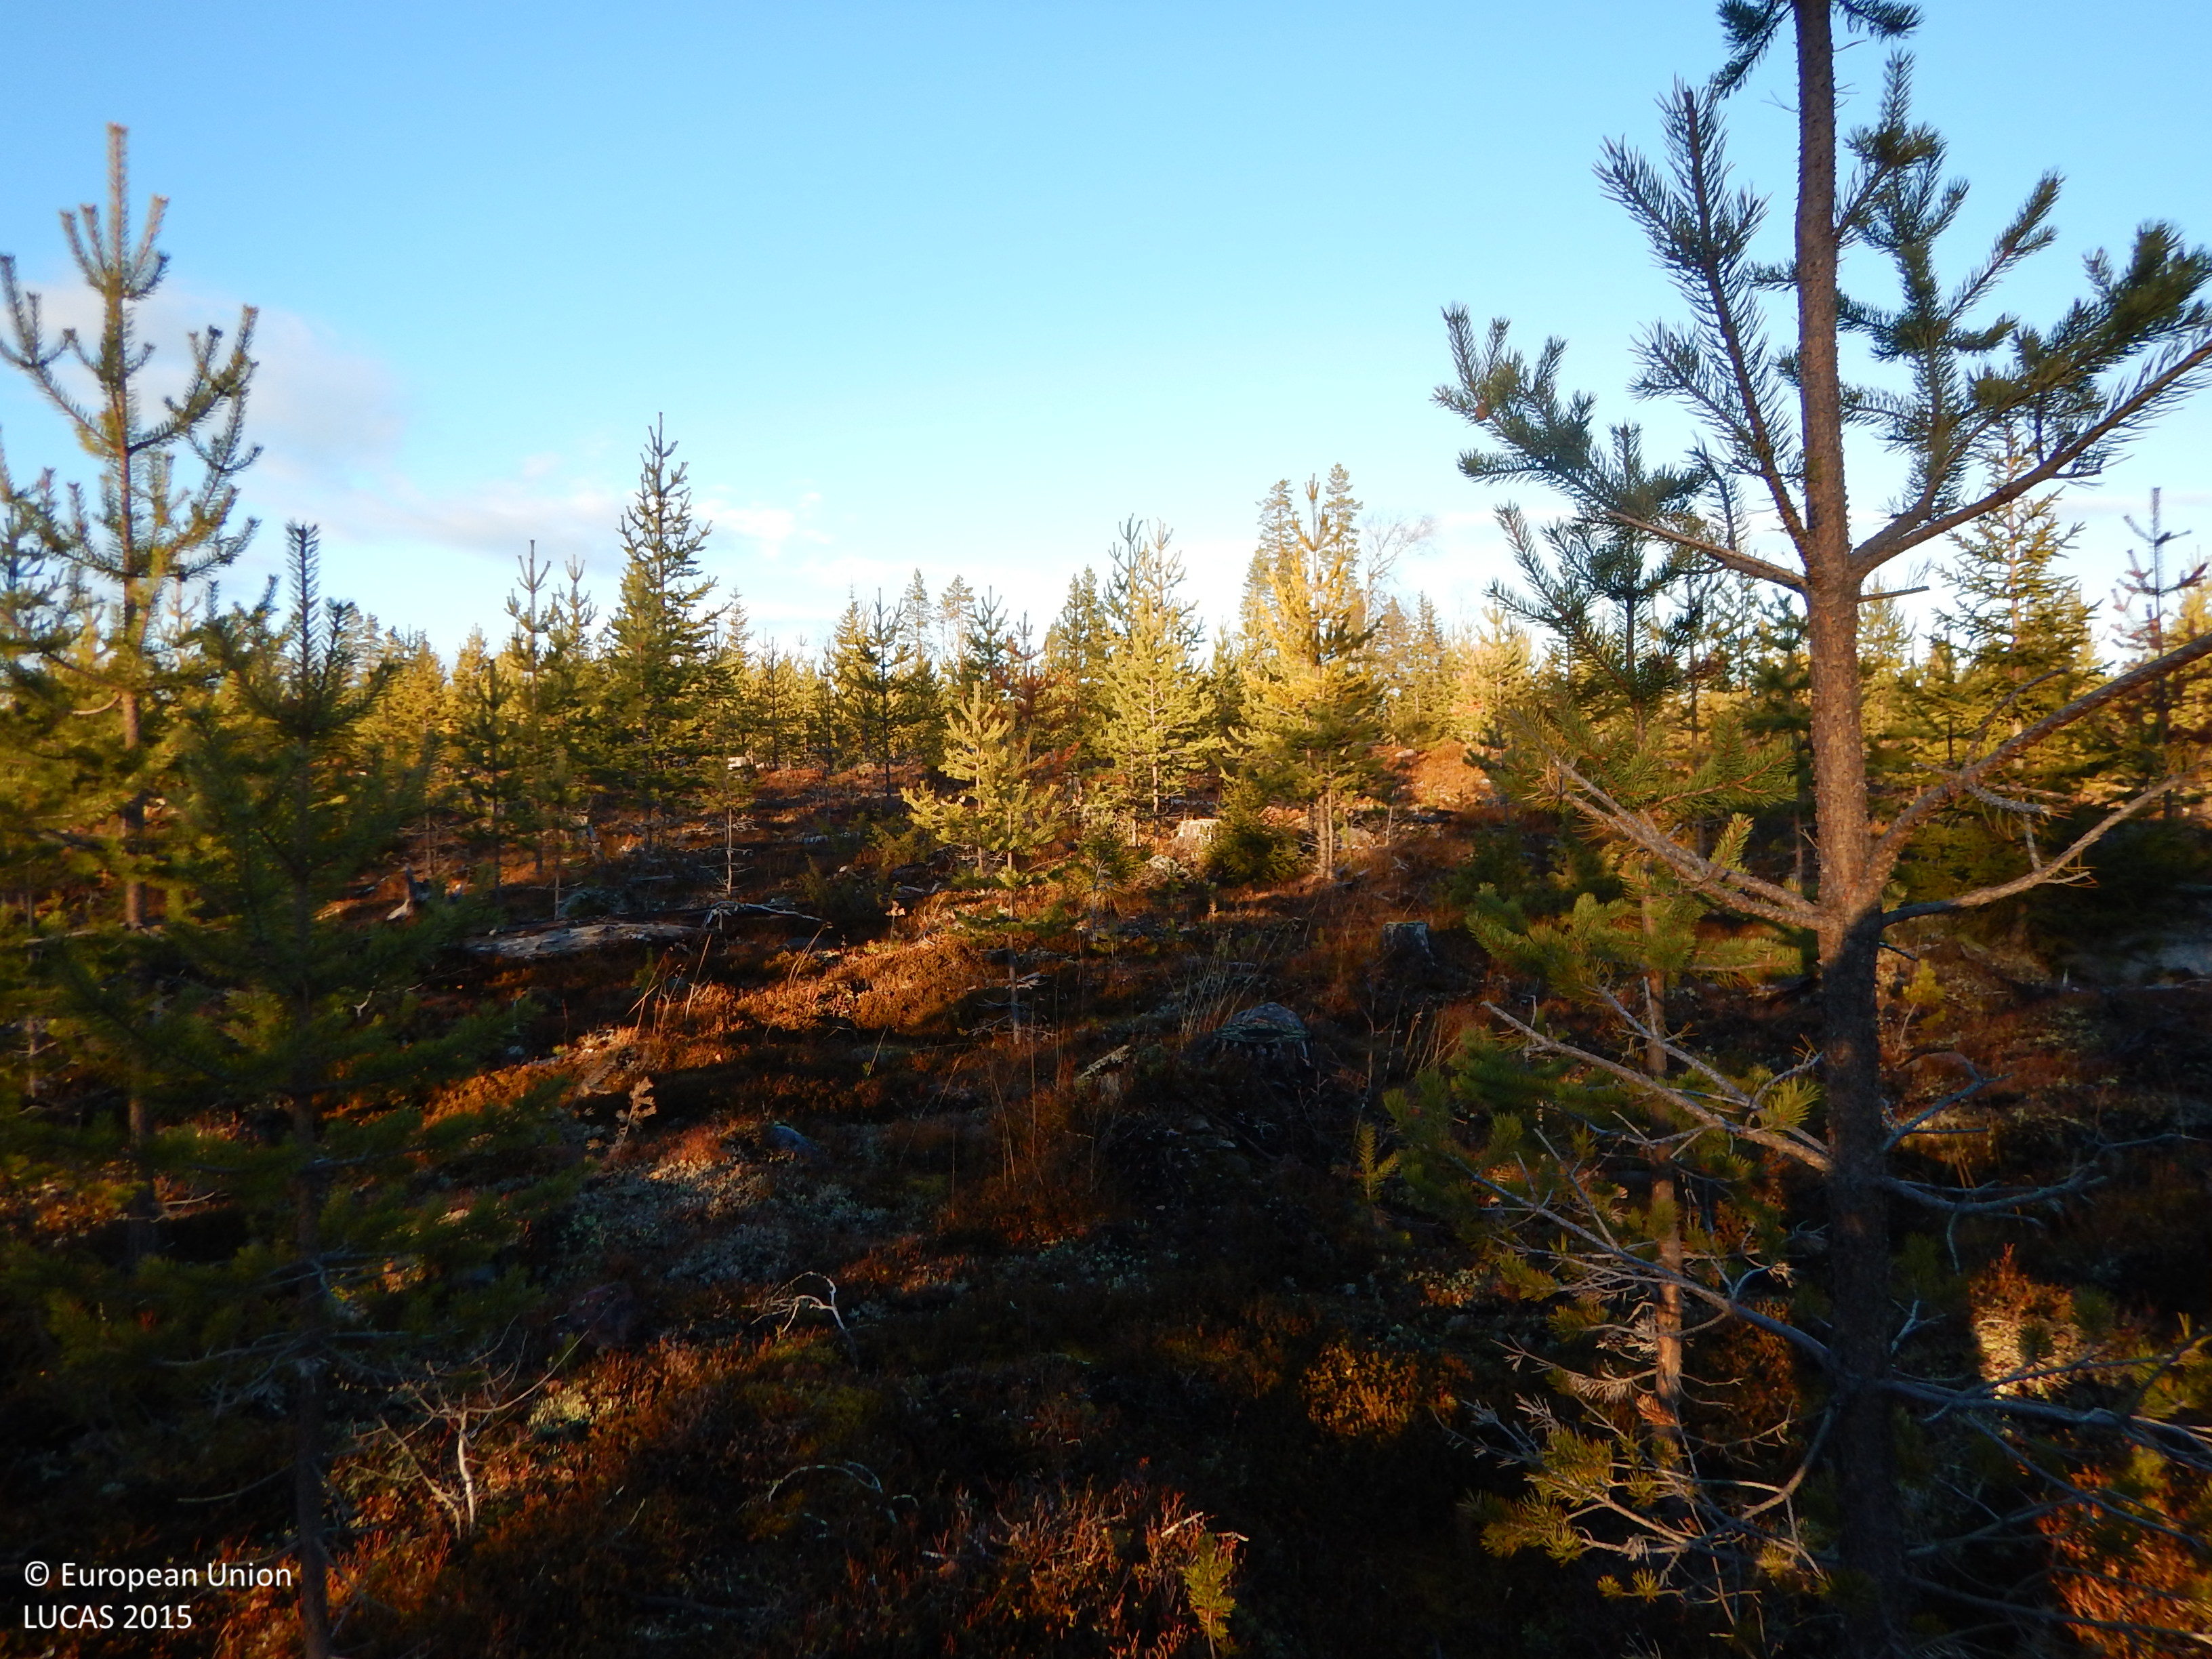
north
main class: Woodland
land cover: Pine dominated coniferous woodland
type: boreal forest
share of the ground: 50 - 75 %
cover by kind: coniferous forest trees 50 %, shrubs 25 %, lichens and mosses 20 %, broadleaved forest trees 5 %
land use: Forestry
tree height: < 5 m
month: November
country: SE
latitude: 65.3718
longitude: 20.6578
